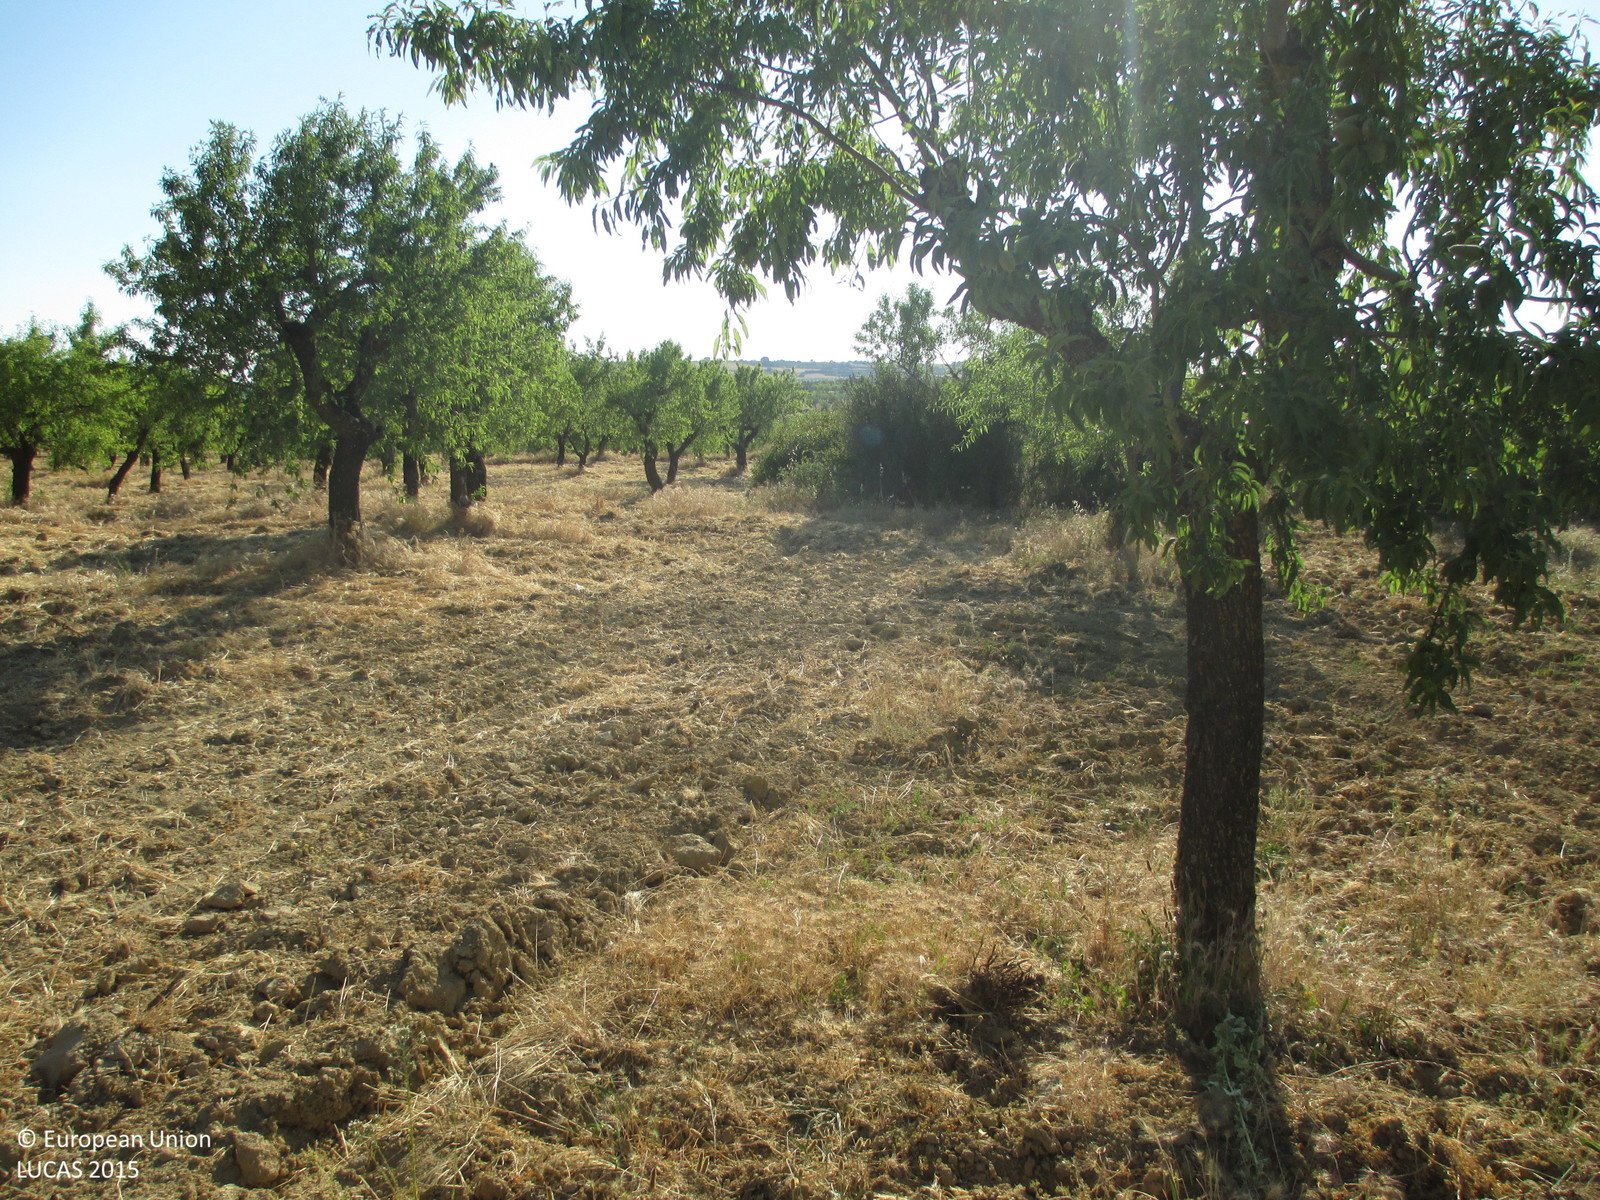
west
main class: Cropland
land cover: Nuts trees
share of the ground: 50 - 75 %
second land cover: Other bare soil
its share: > 75 %
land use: Agriculture (excluding fallow land and kitchen gardens)
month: June
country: ES
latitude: 42.1217
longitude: 0.0012
